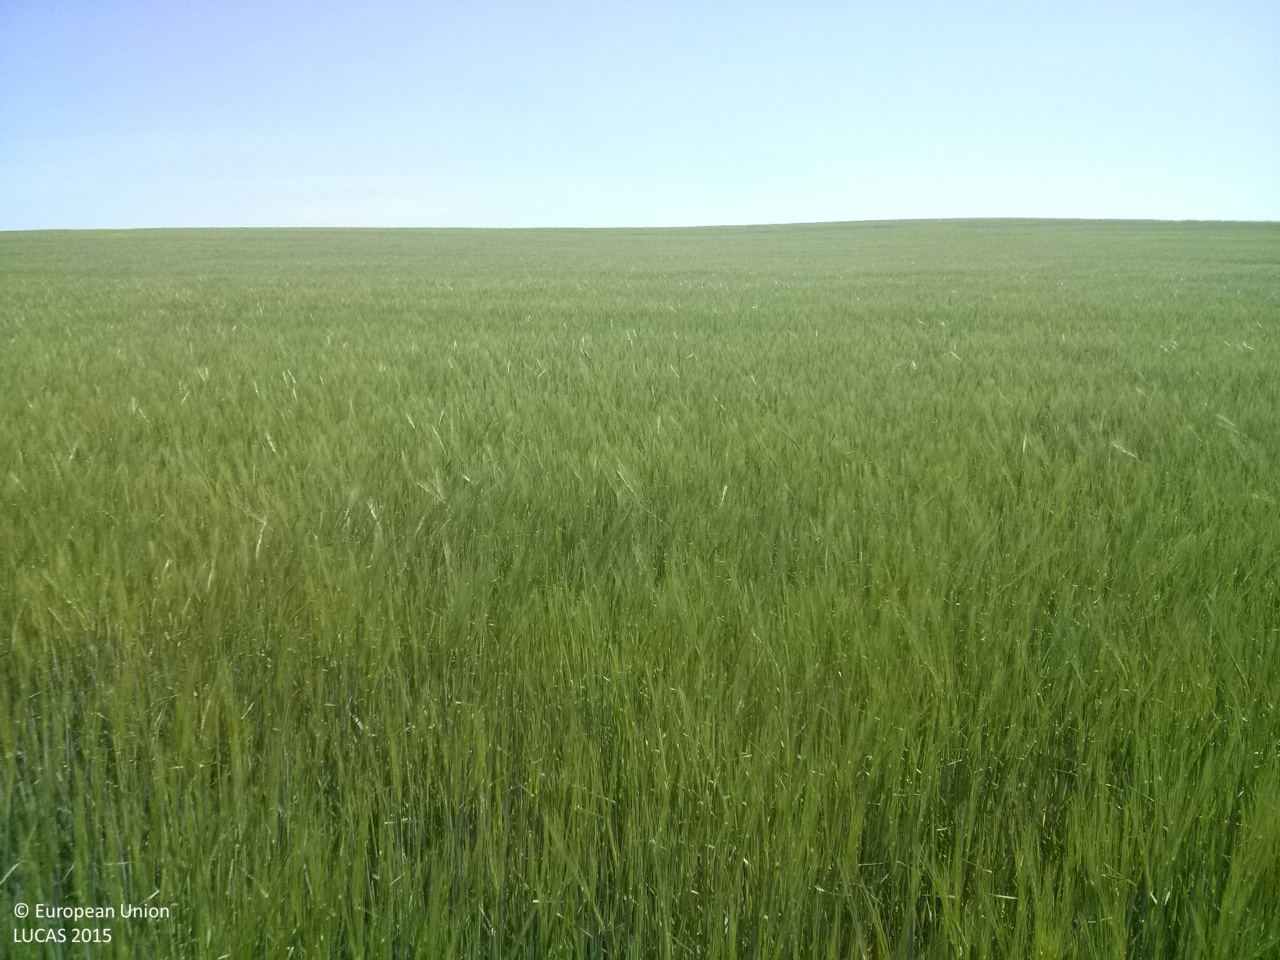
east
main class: Cropland
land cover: Barley
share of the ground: > 75 %
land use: Agriculture (excluding fallow land and kitchen gardens)
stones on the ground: < 10 %
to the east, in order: Barley; Grass margins; Tracks; Grass margins; Other bare soil
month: May
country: ES
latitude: 39.8259
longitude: -2.8130
